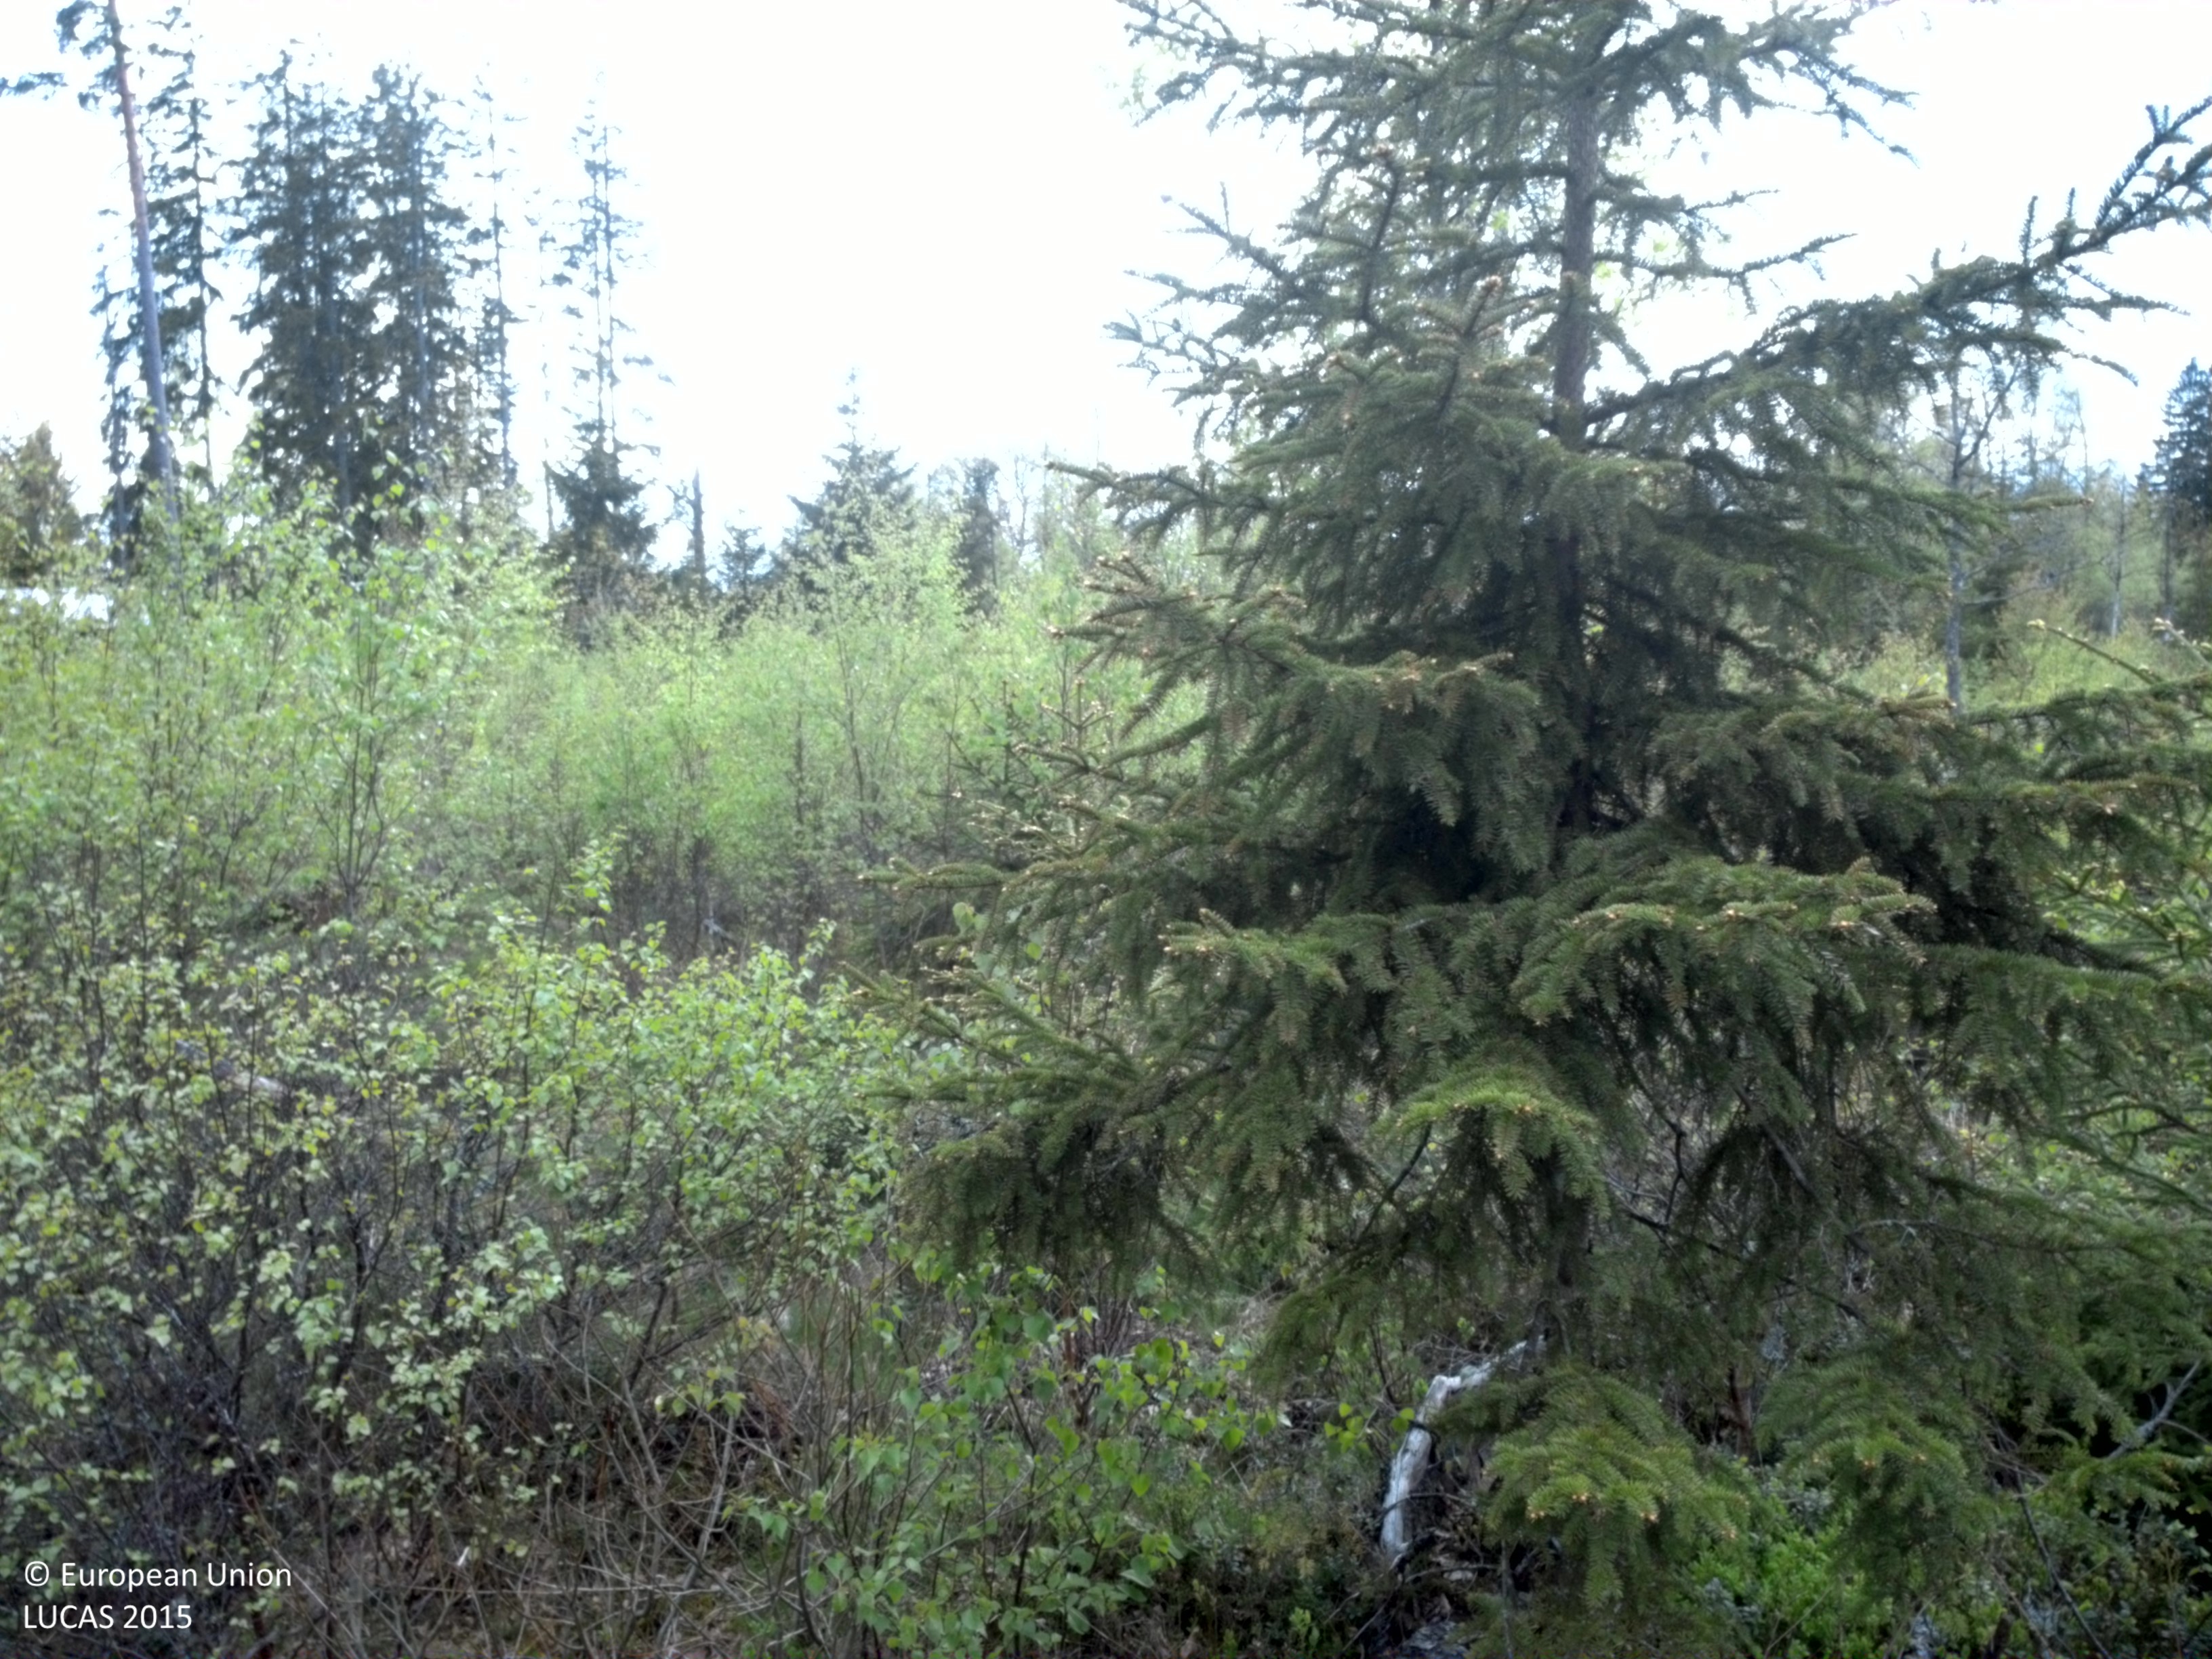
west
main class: Woodland
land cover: Spruce dominated mixed woodland
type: boreal forest
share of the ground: > 75 %
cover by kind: coniferous forest trees 40 %, broadleaved forest trees 40 %, shrubs 10 %, herbaceous plants 10 %
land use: Forestry
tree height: < 5 m
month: May
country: SE
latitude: 56.8010
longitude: 15.2544
